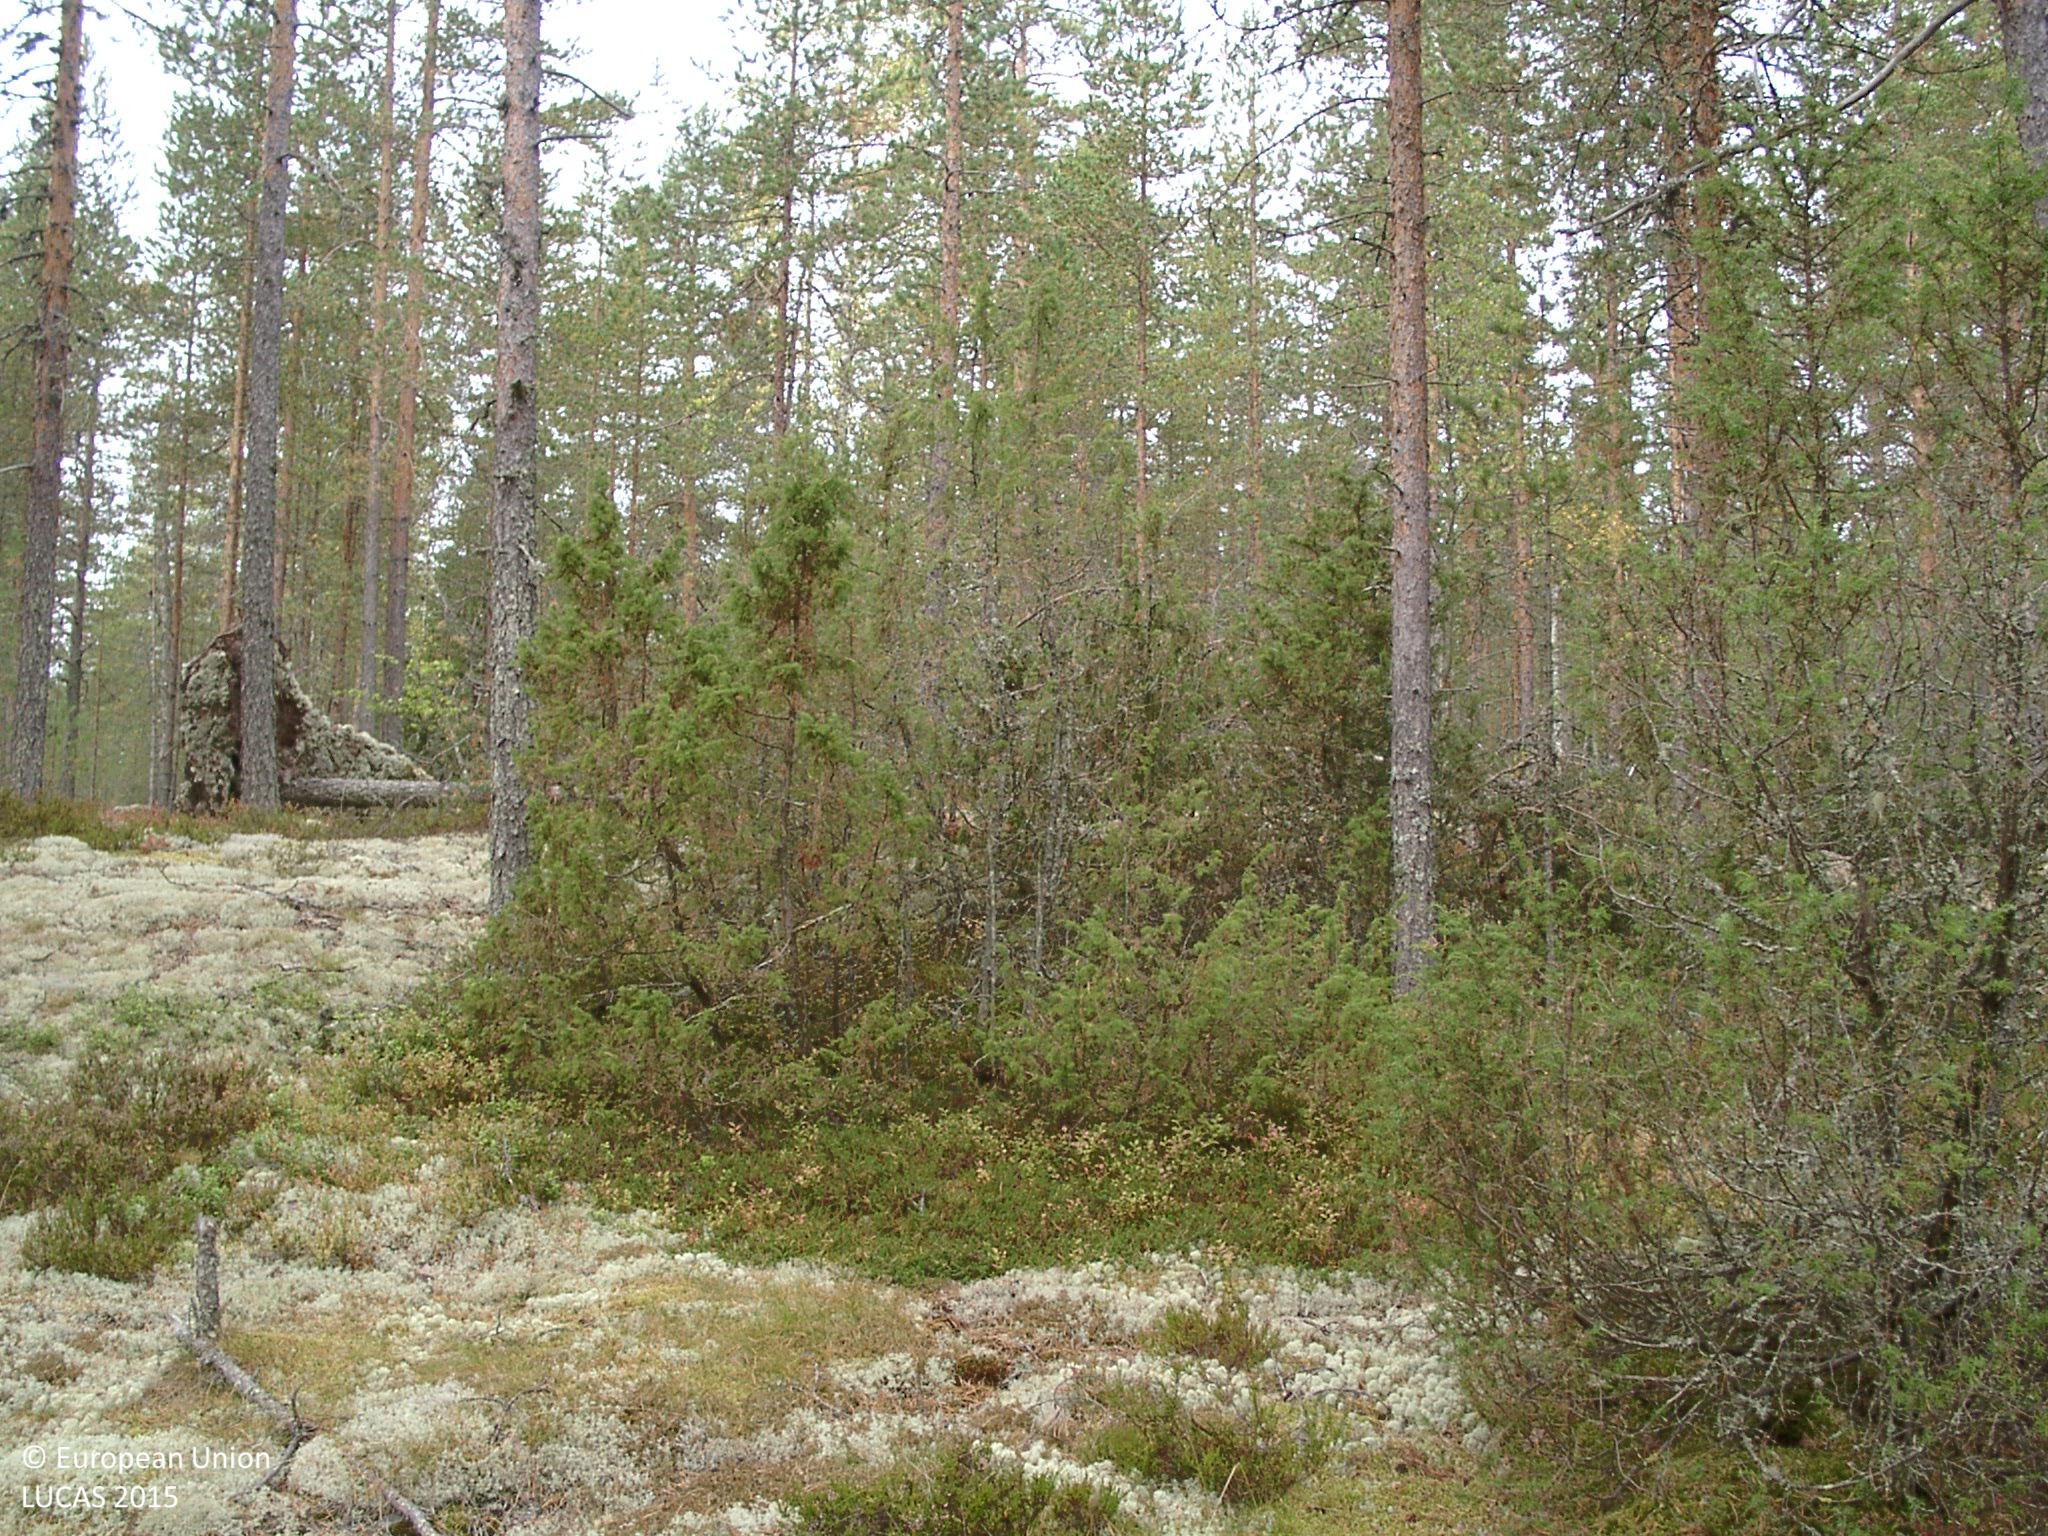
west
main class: Woodland
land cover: Pine dominated coniferous woodland
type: boreal forest
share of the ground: 25 - 50 %
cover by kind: lichens and mosses 45 %, shrubs 30 %, coniferous forest trees 25 %
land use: Forestry
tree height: > 5 m
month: September
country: FI
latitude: 62.5312
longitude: 25.7612
